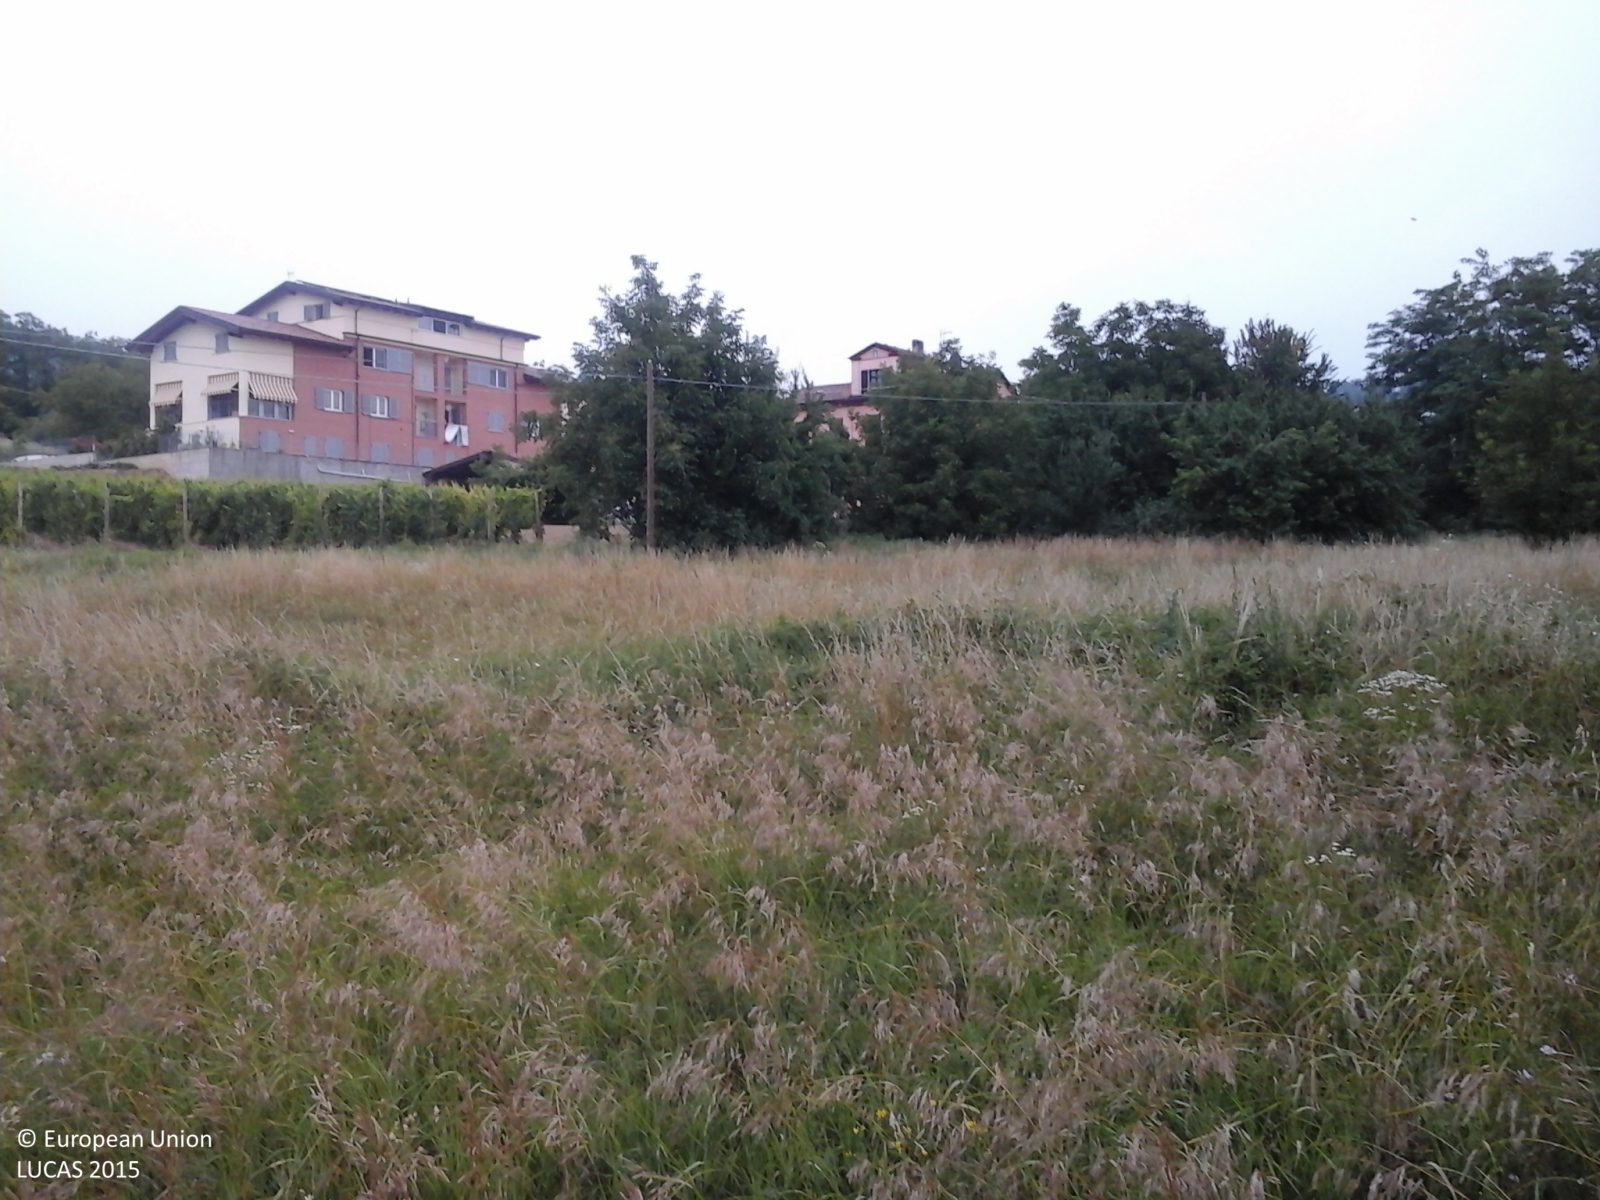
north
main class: Grassland
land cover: Grassland without tree/shrub cover
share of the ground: > 75 %
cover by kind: herbaceous plants 100 %
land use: Agriculture (excluding fallow land and kitchen gardens)
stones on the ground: < 10 %
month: July
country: IT
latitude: 44.6817
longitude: 8.4514
